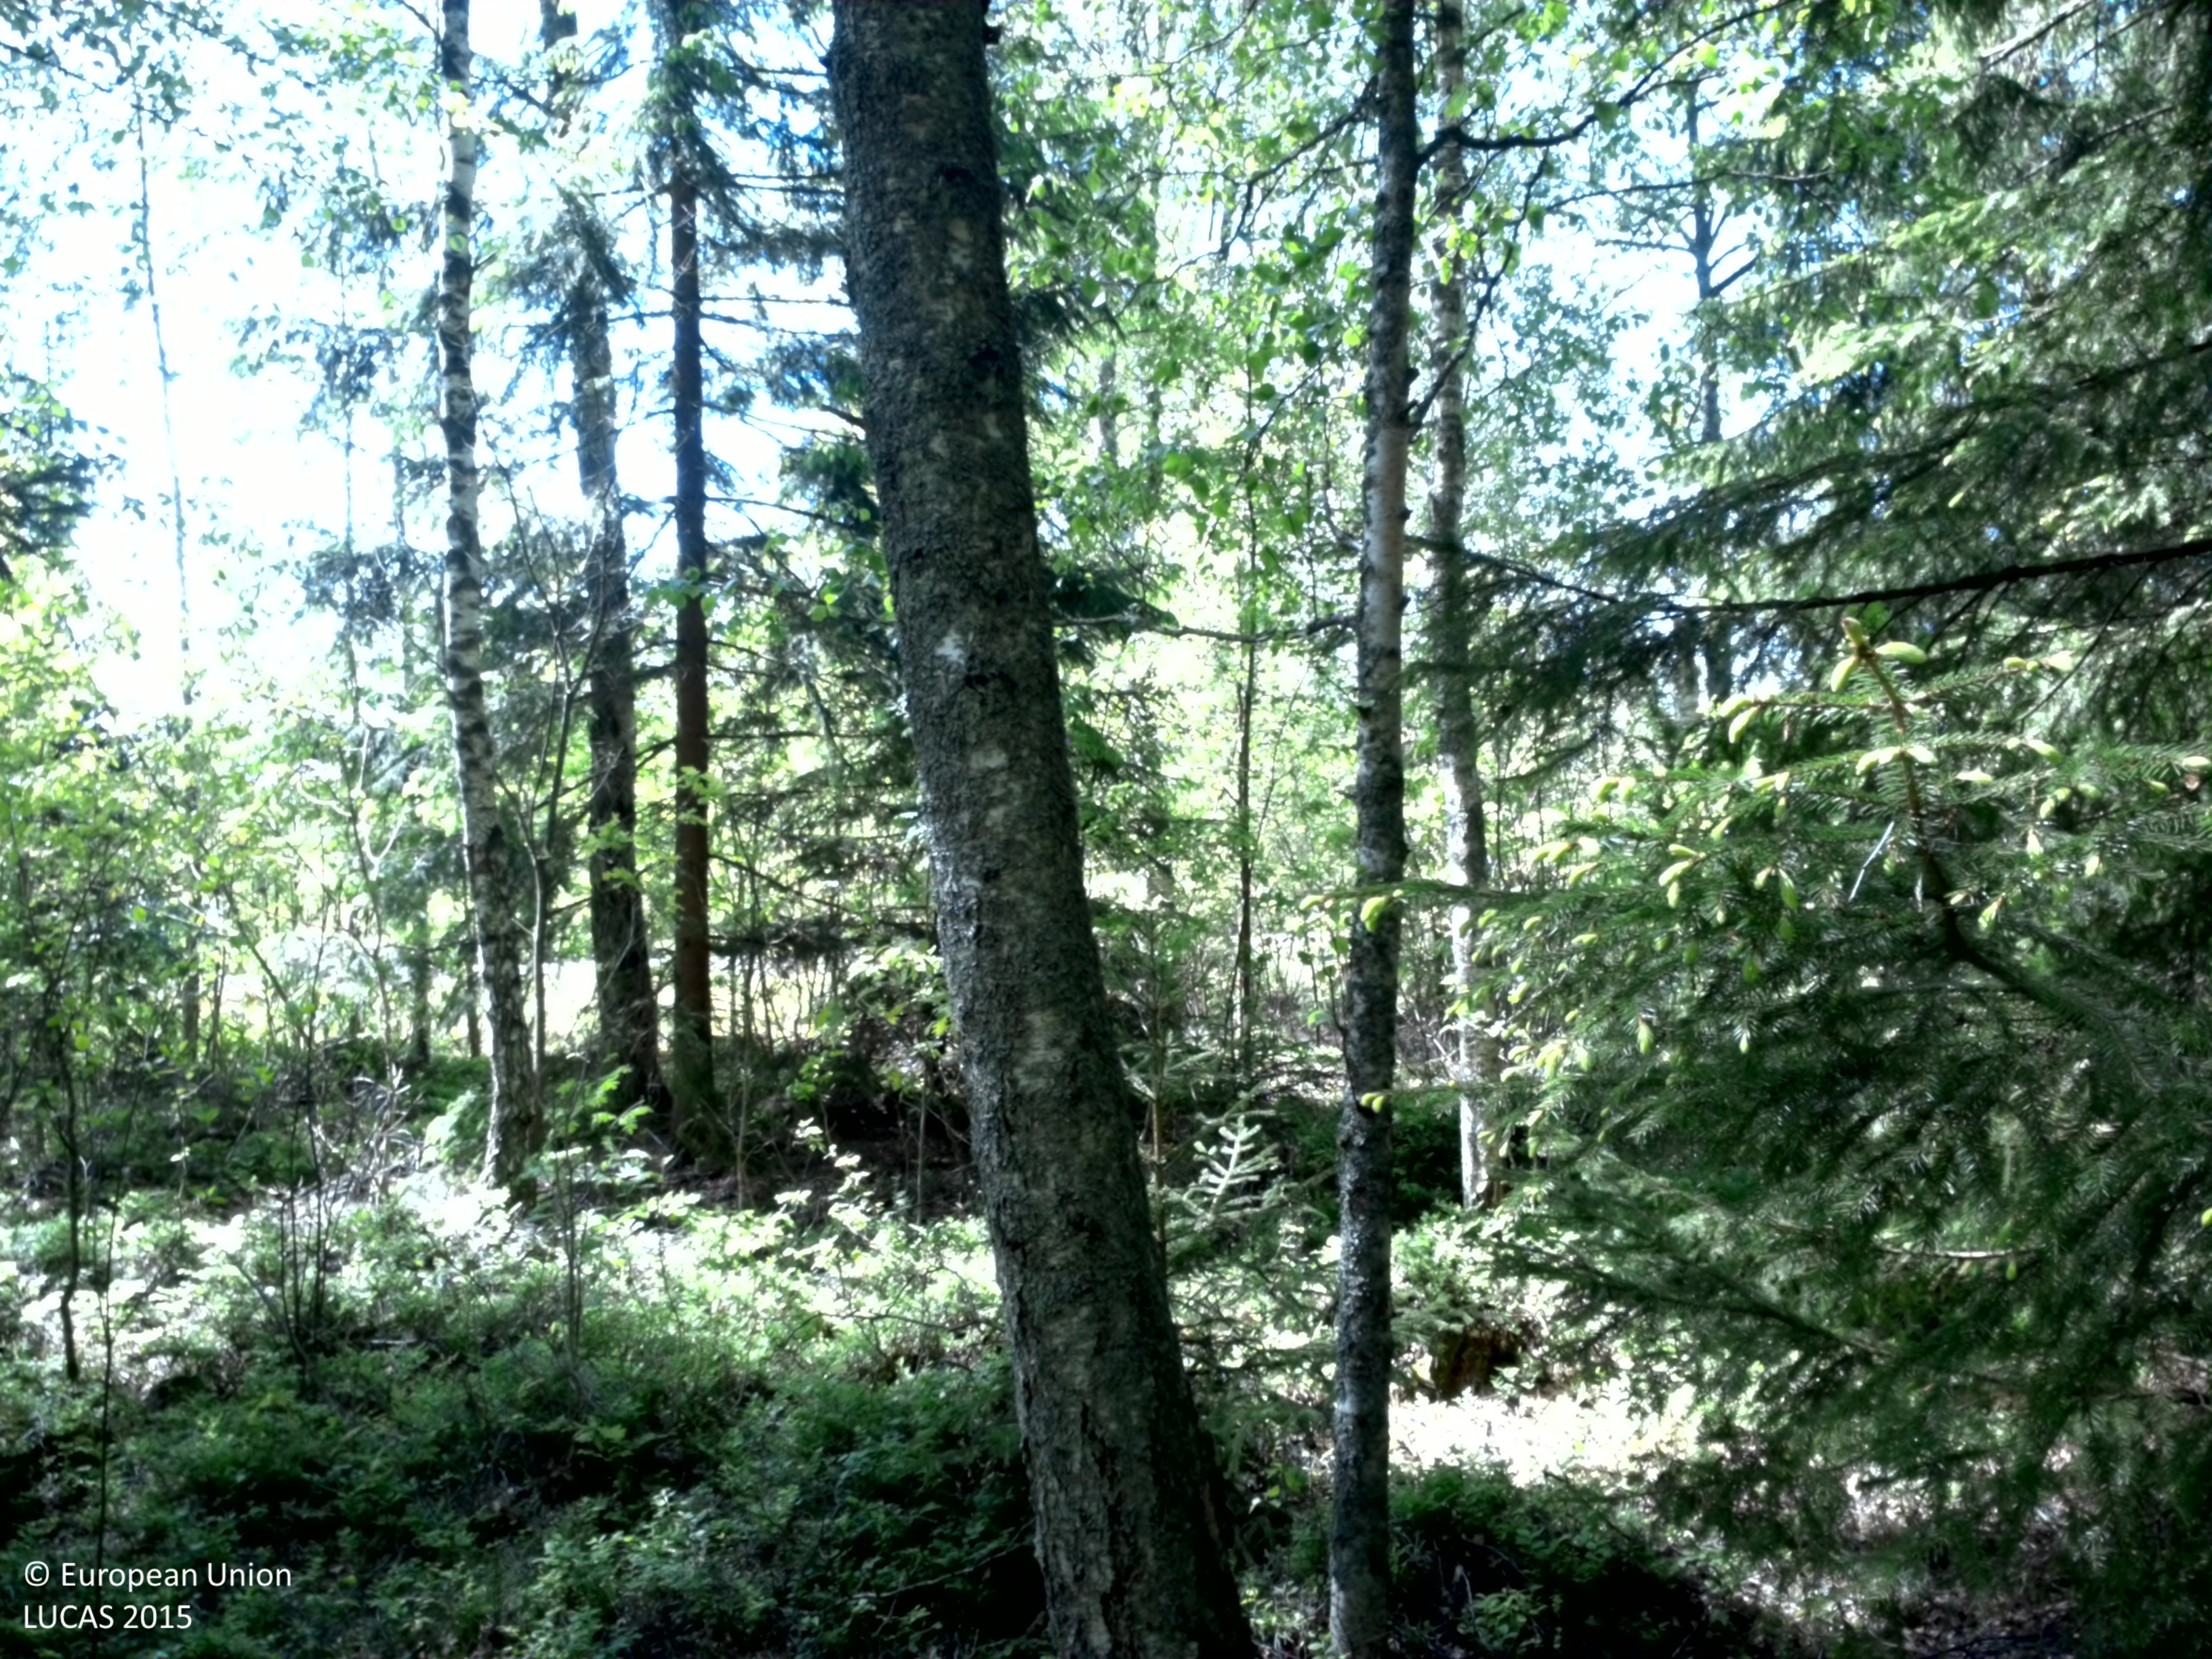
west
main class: Woodland
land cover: Spruce dominated mixed woodland
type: boreal forest
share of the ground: 50 - 75 %
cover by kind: broadleaved forest trees 40 %, coniferous forest trees 25 %, shrubs 20 %, lichens and mosses 10 %, herbaceous plants 5 %
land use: Forestry
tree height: > 5 m
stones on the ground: < 10 %
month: June
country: SE
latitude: 56.6596
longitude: 14.7122
